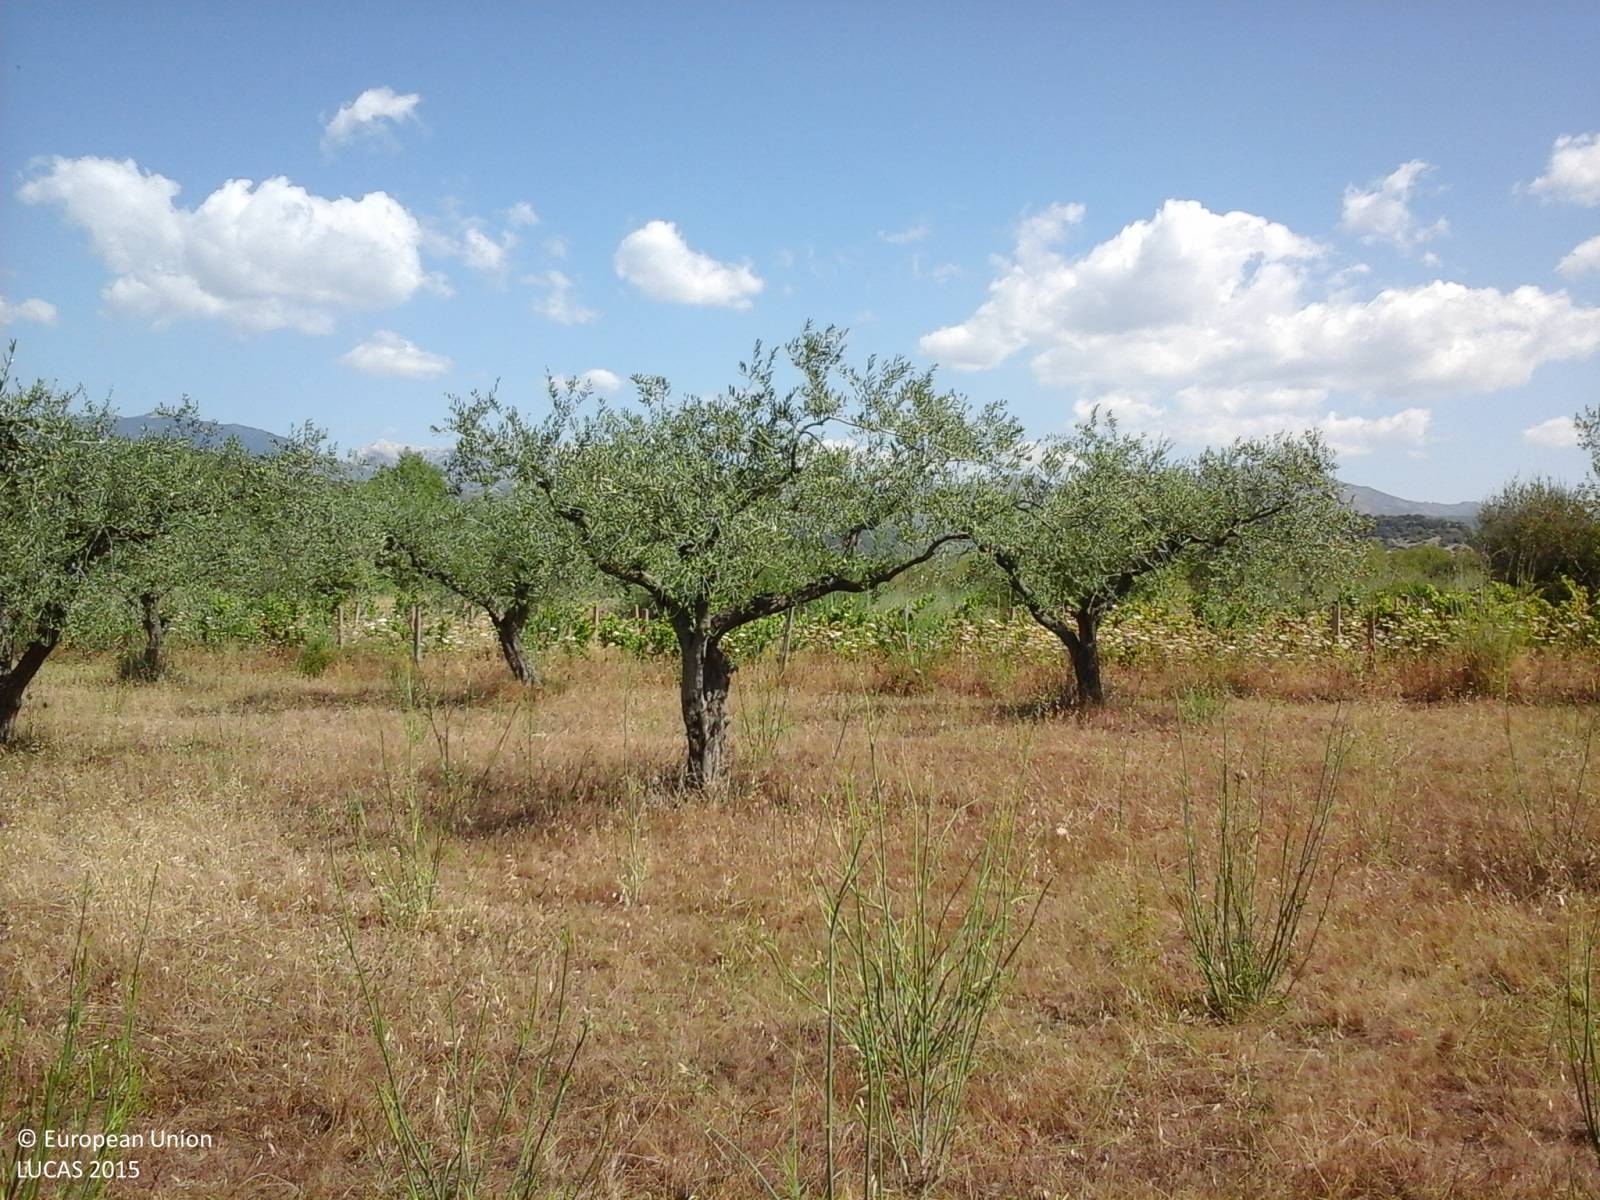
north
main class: Cropland
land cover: Olive groves
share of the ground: > 75 %
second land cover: Grassland without tree/shrub cover
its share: > 75 %
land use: Agriculture (excluding fallow land and kitchen gardens)
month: June
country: IT
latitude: 40.3751
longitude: 9.5899
